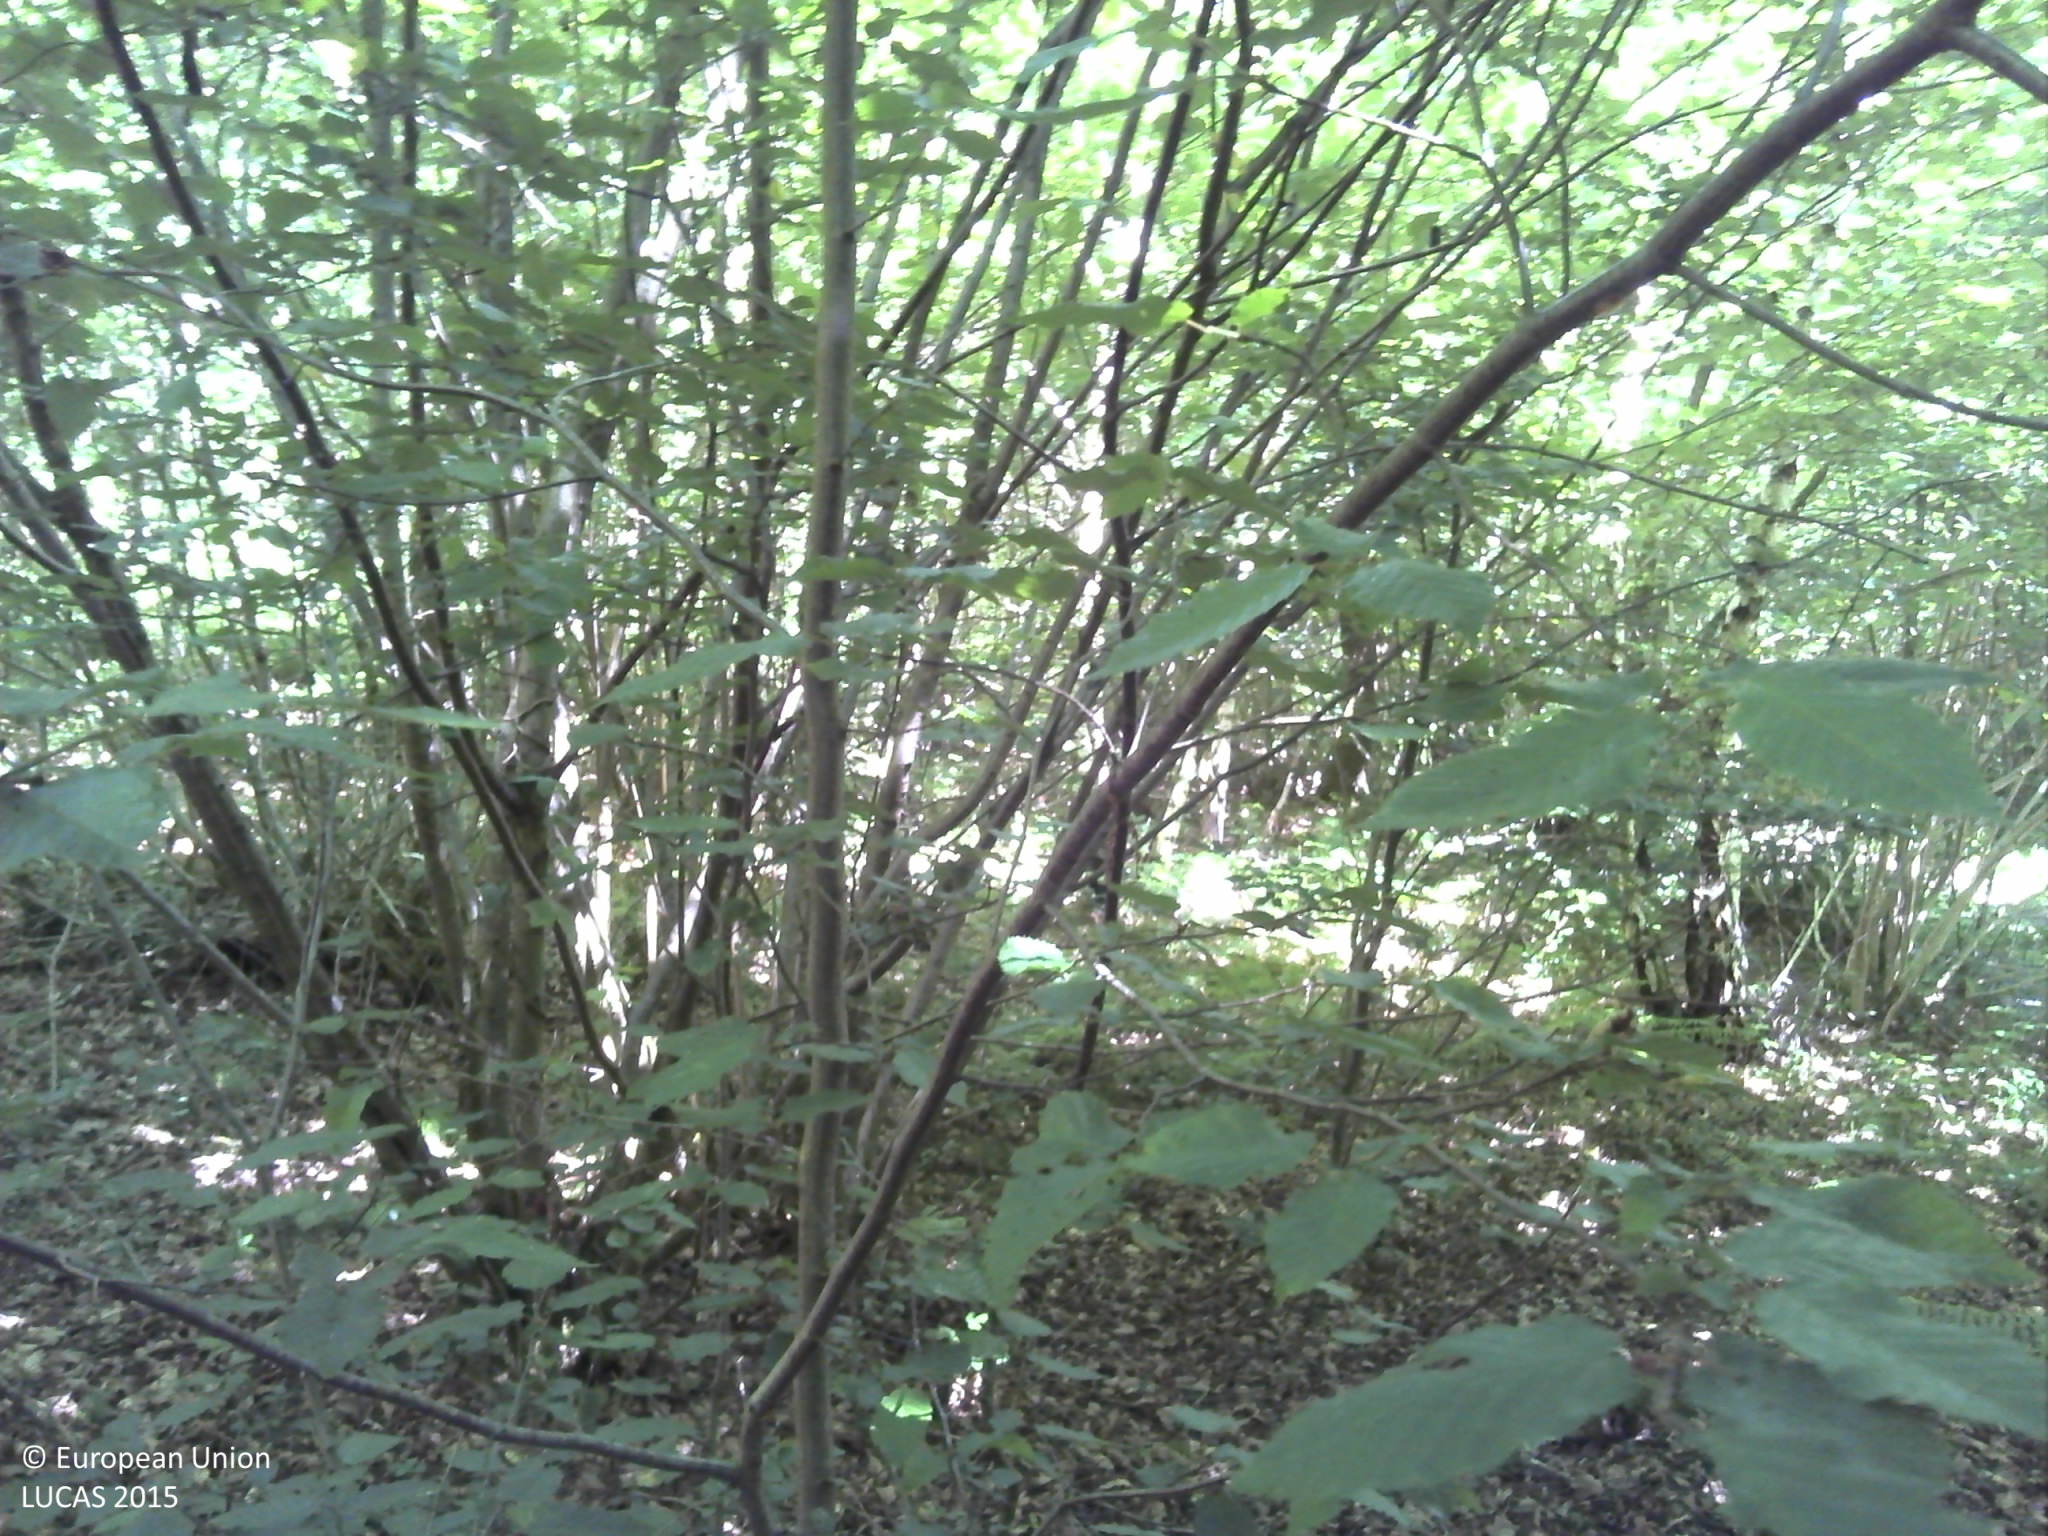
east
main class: Woodland
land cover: Broadleaved woodland
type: acidophilous oak and oak-birch forest
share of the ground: > 75 %
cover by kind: broadleaved forest trees 70 %, herbaceous plants 15 %, consolidated bare surface 10 %, lichens and mosses 5 %
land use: Forestry
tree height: > 5 m
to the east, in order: Broadleaved woodland; Tracks; Broadleaved woodland; Tracks; Broadleaved woodland; Paved roads, cycling and walking lanes; Grass margins; Fences; Paved roads, cycling and walking lanes; Fences; Grass margins; Tracks; Spontaneously vegetated surfaces
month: June
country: FR
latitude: 50.0291
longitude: 4.7899
